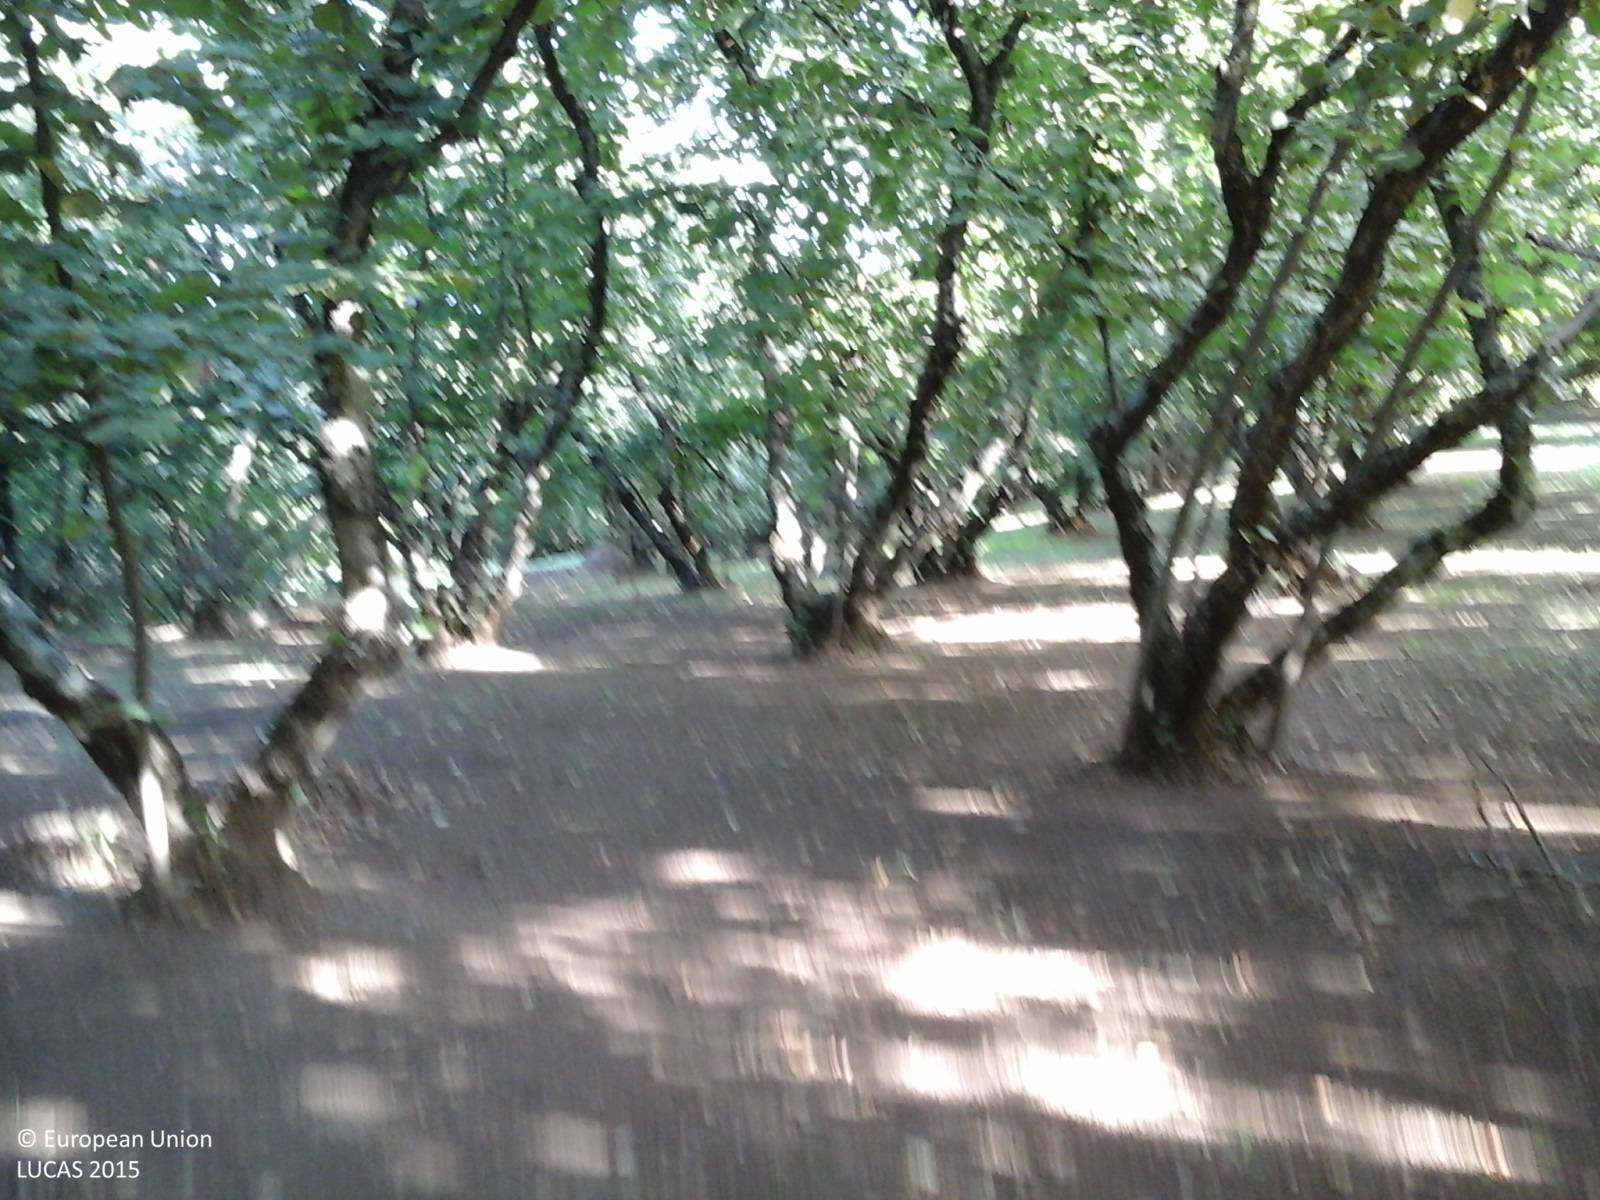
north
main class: Cropland
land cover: Nuts trees
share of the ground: > 75 %
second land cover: Grassland without tree/shrub cover
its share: > 75 %
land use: Agriculture (excluding fallow land and kitchen gardens)
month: September
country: IT
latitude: 42.3938
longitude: 12.2639
